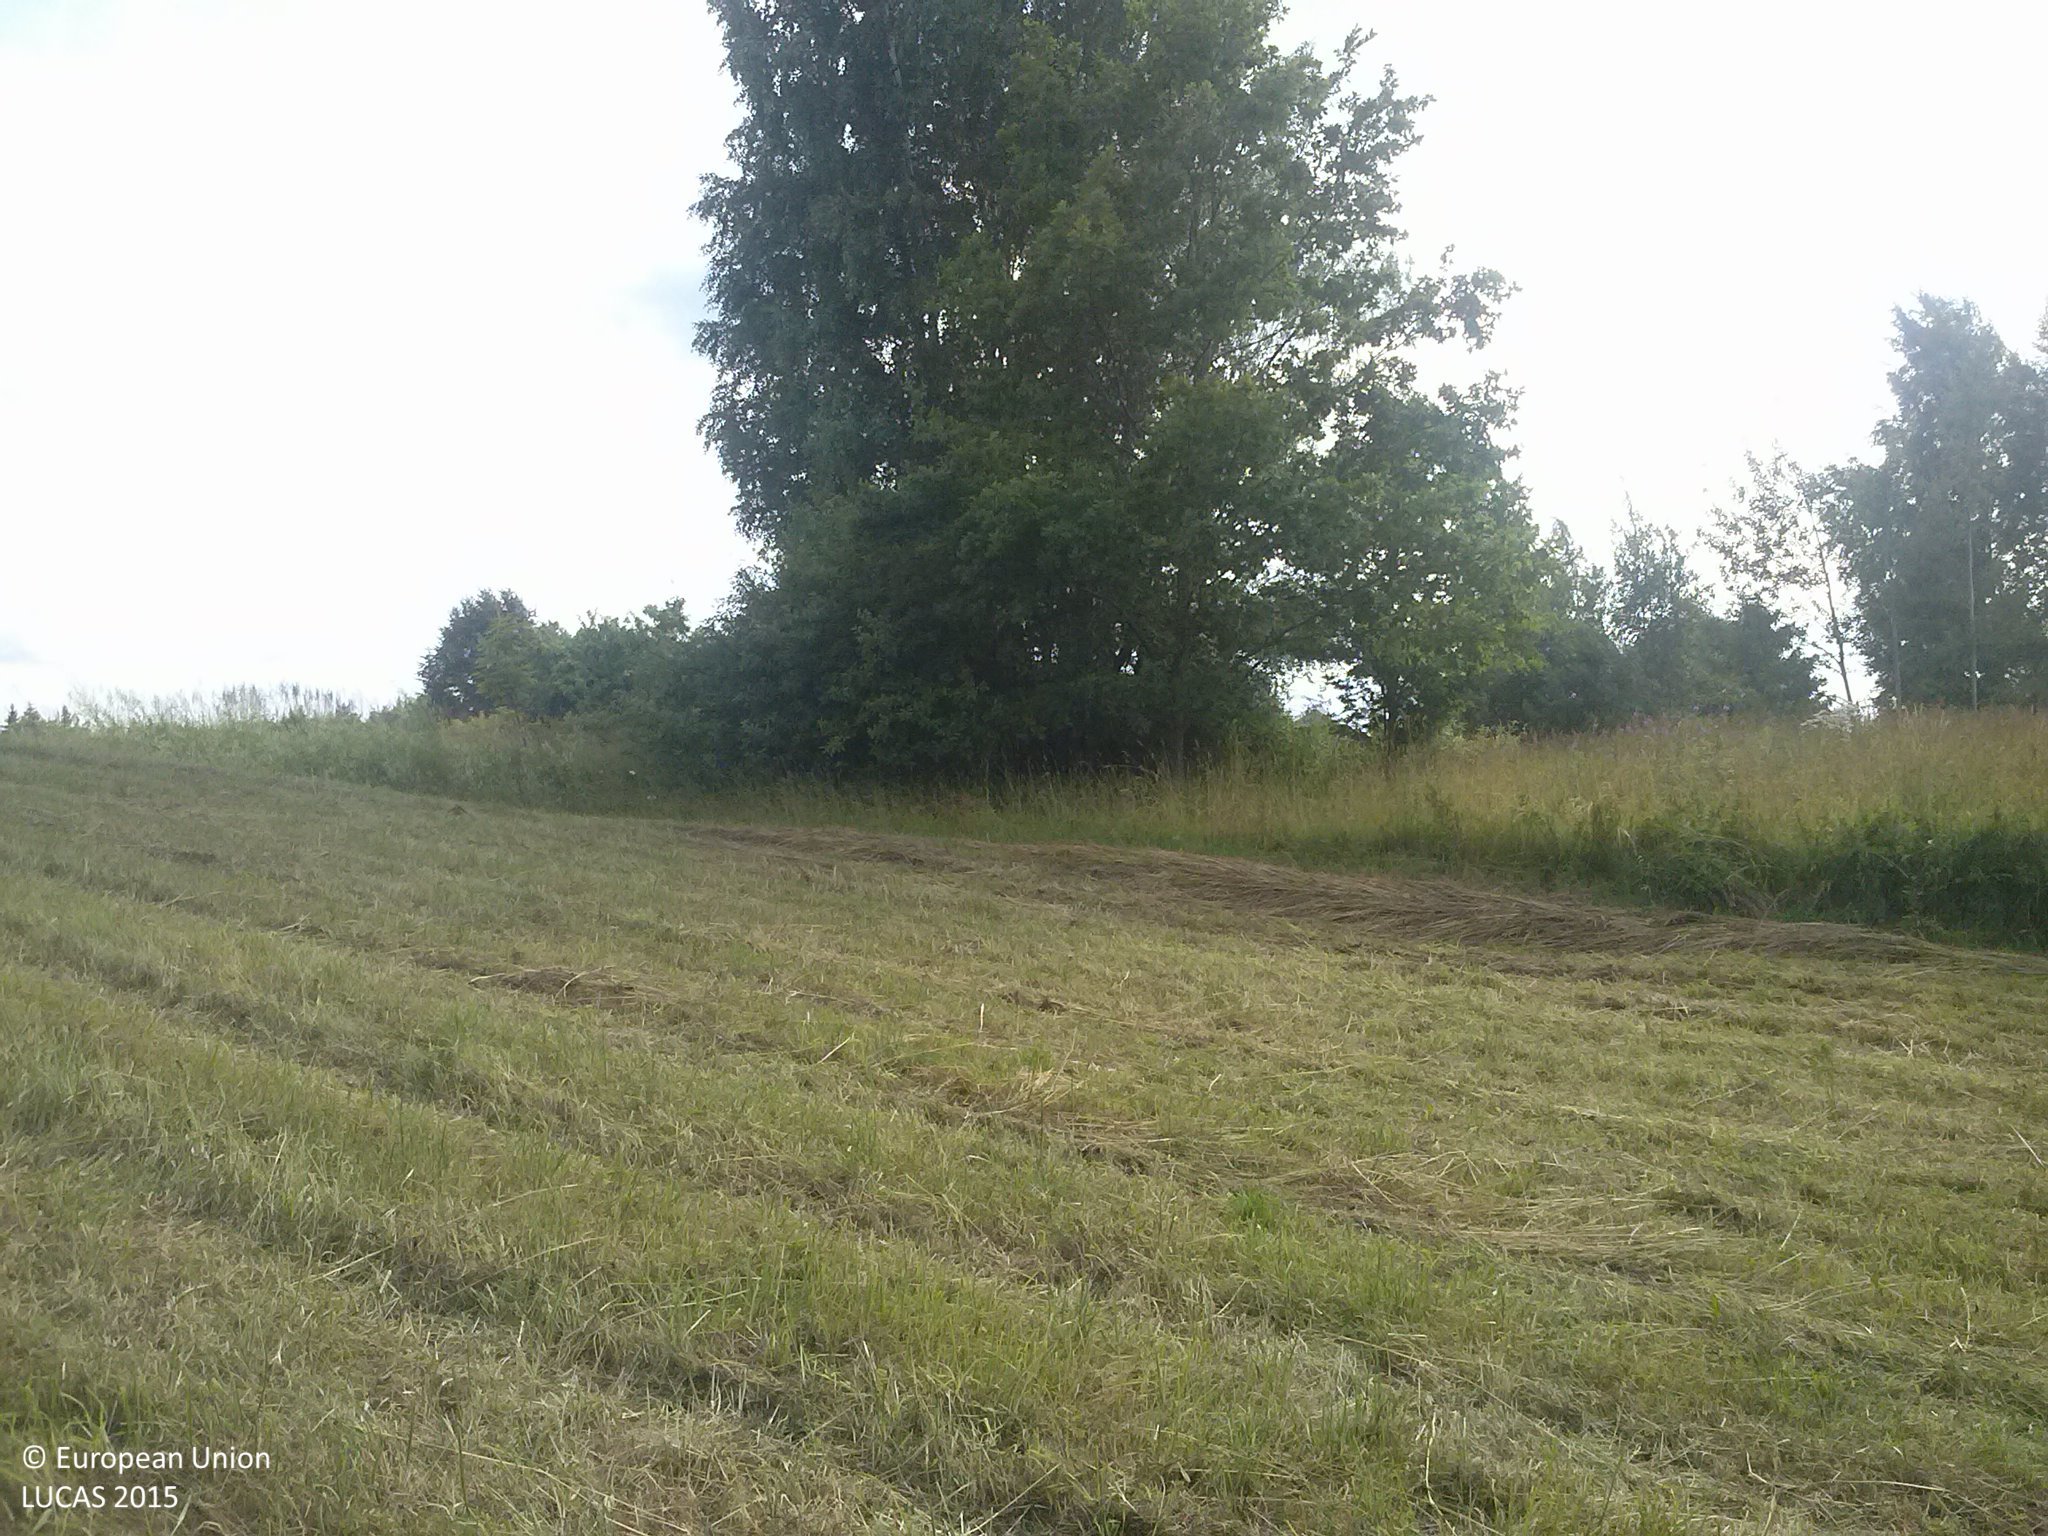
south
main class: Grassland
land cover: Grassland without tree/shrub cover
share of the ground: > 75 %
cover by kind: herbaceous plants 100 %
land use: Agriculture (excluding fallow land and kitchen gardens)
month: July
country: LV
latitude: 56.6439
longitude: 27.4123
